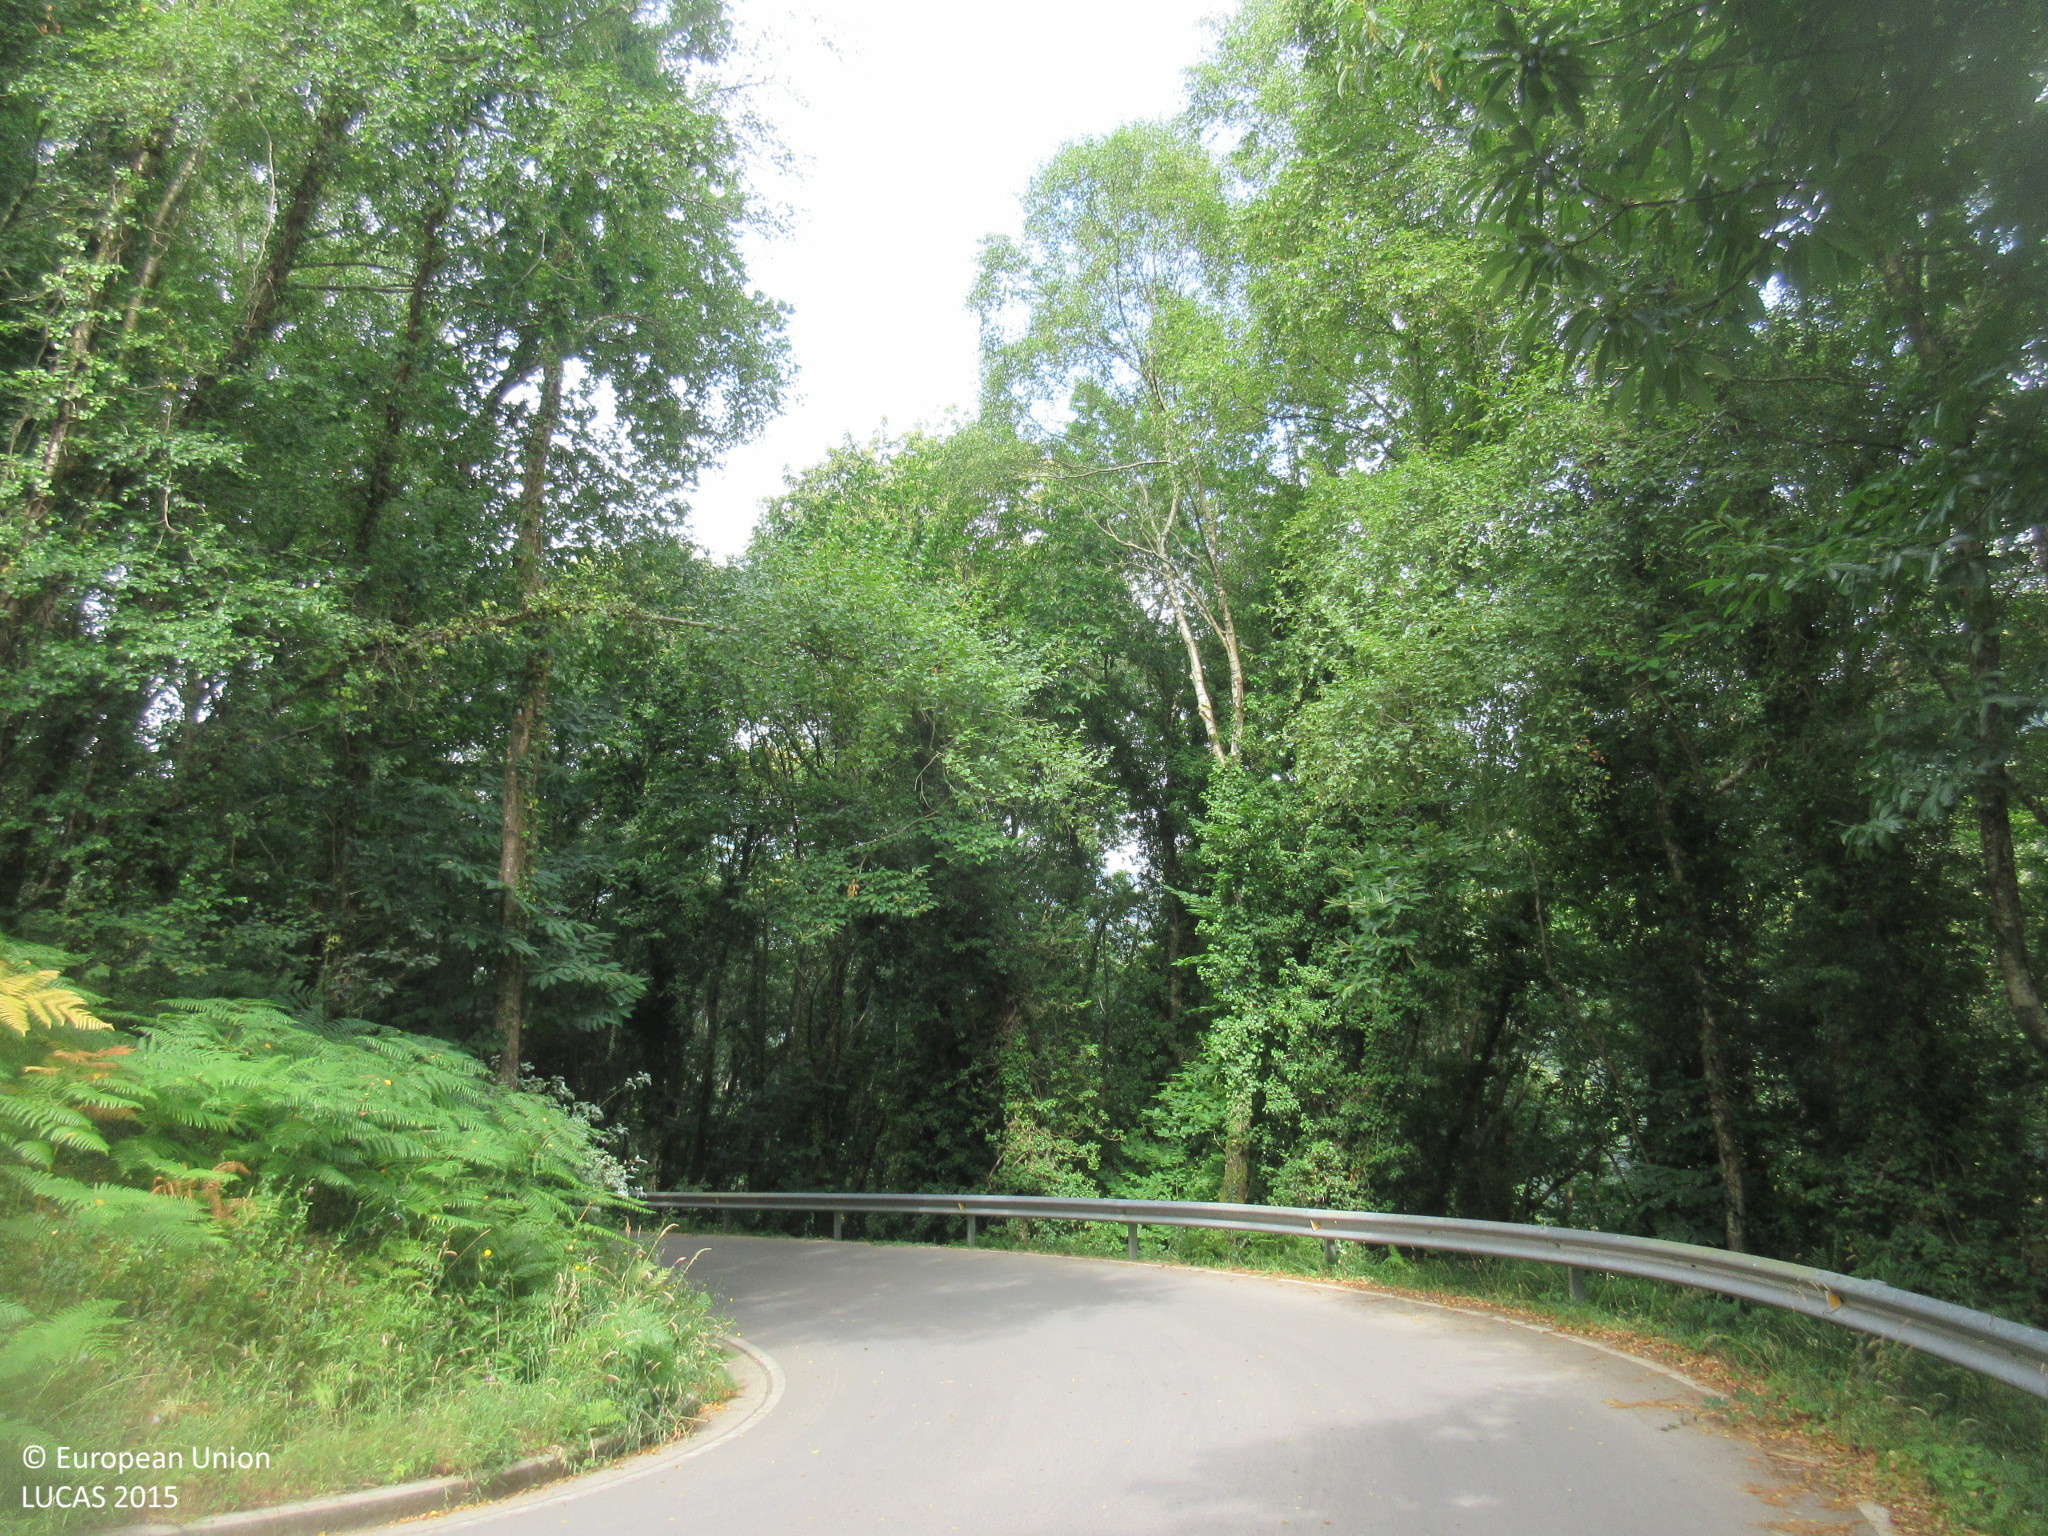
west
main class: Woodland
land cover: Broadleaved woodland
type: thermophilous deciduous forest
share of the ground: > 75 %
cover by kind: broadleaved forest trees 95 %, shrubs 5 %
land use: Forestry
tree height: > 5 m
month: July
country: ES
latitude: 43.4474
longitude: -6.3495
